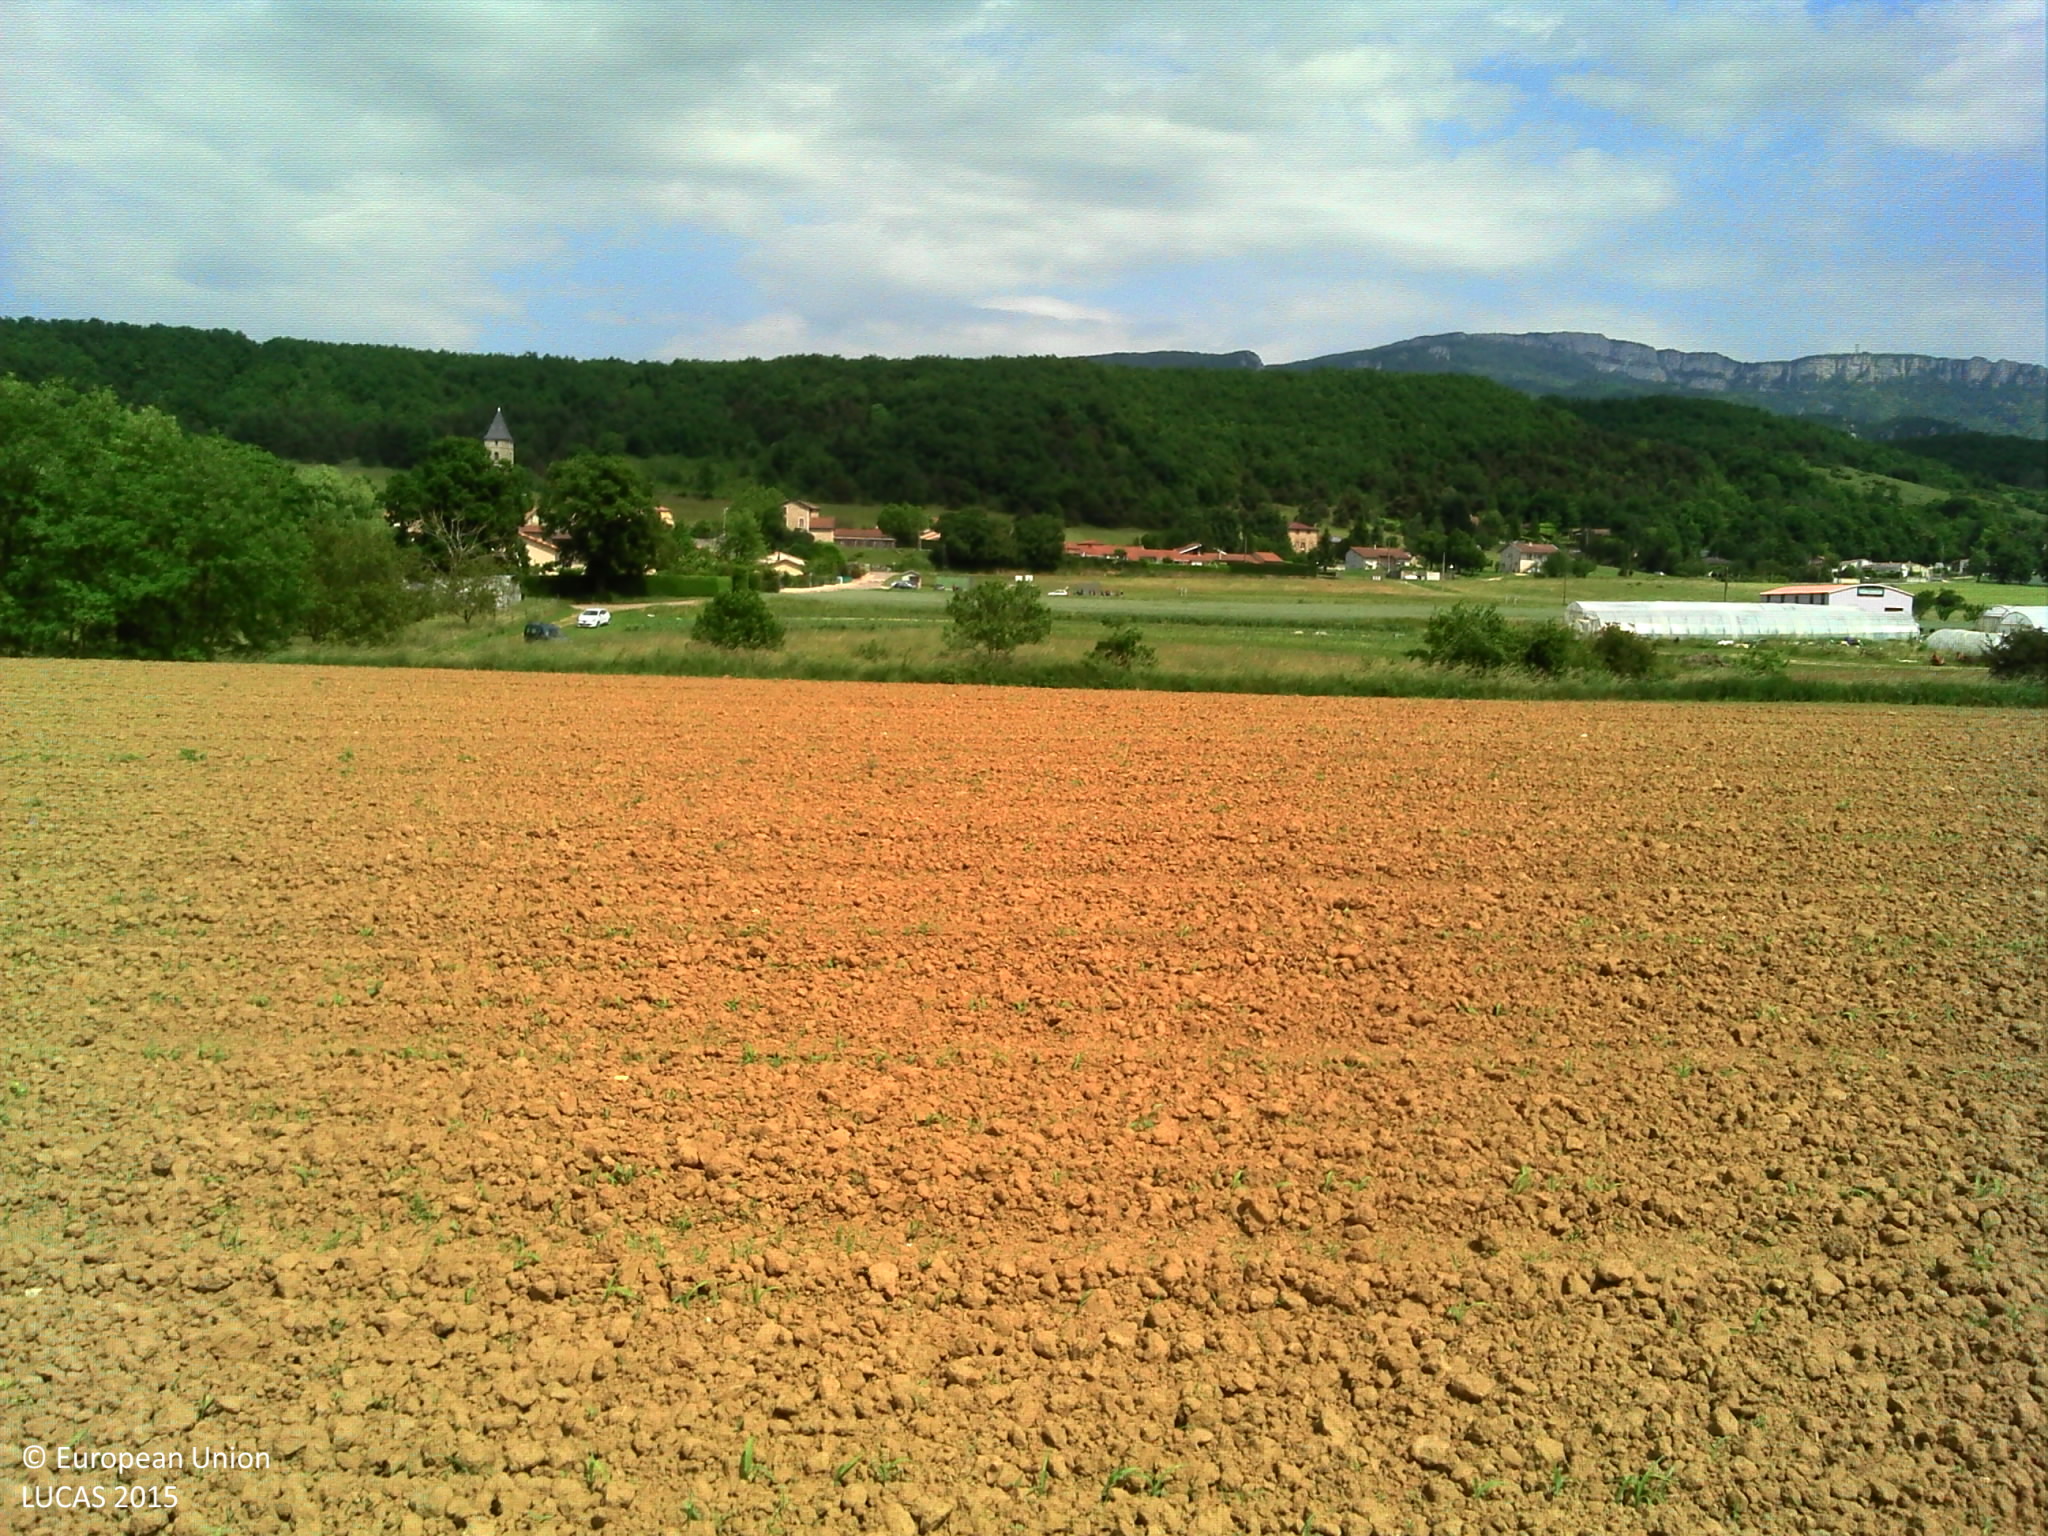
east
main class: Cropland
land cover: Maize
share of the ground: < 10 %
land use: Agriculture (excluding fallow land and kitchen gardens)
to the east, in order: Maize; Tracks; Grassland with sparse tree/shrub cover; Ditches and canals; Fences; Inland fresh water bodies; Grassland without tree/shrub cover; Fences; Tracks; Grassland without tree/shrub cover; Tracks; Common wheat
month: May
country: FR
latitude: 45.0136
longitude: 5.1458
